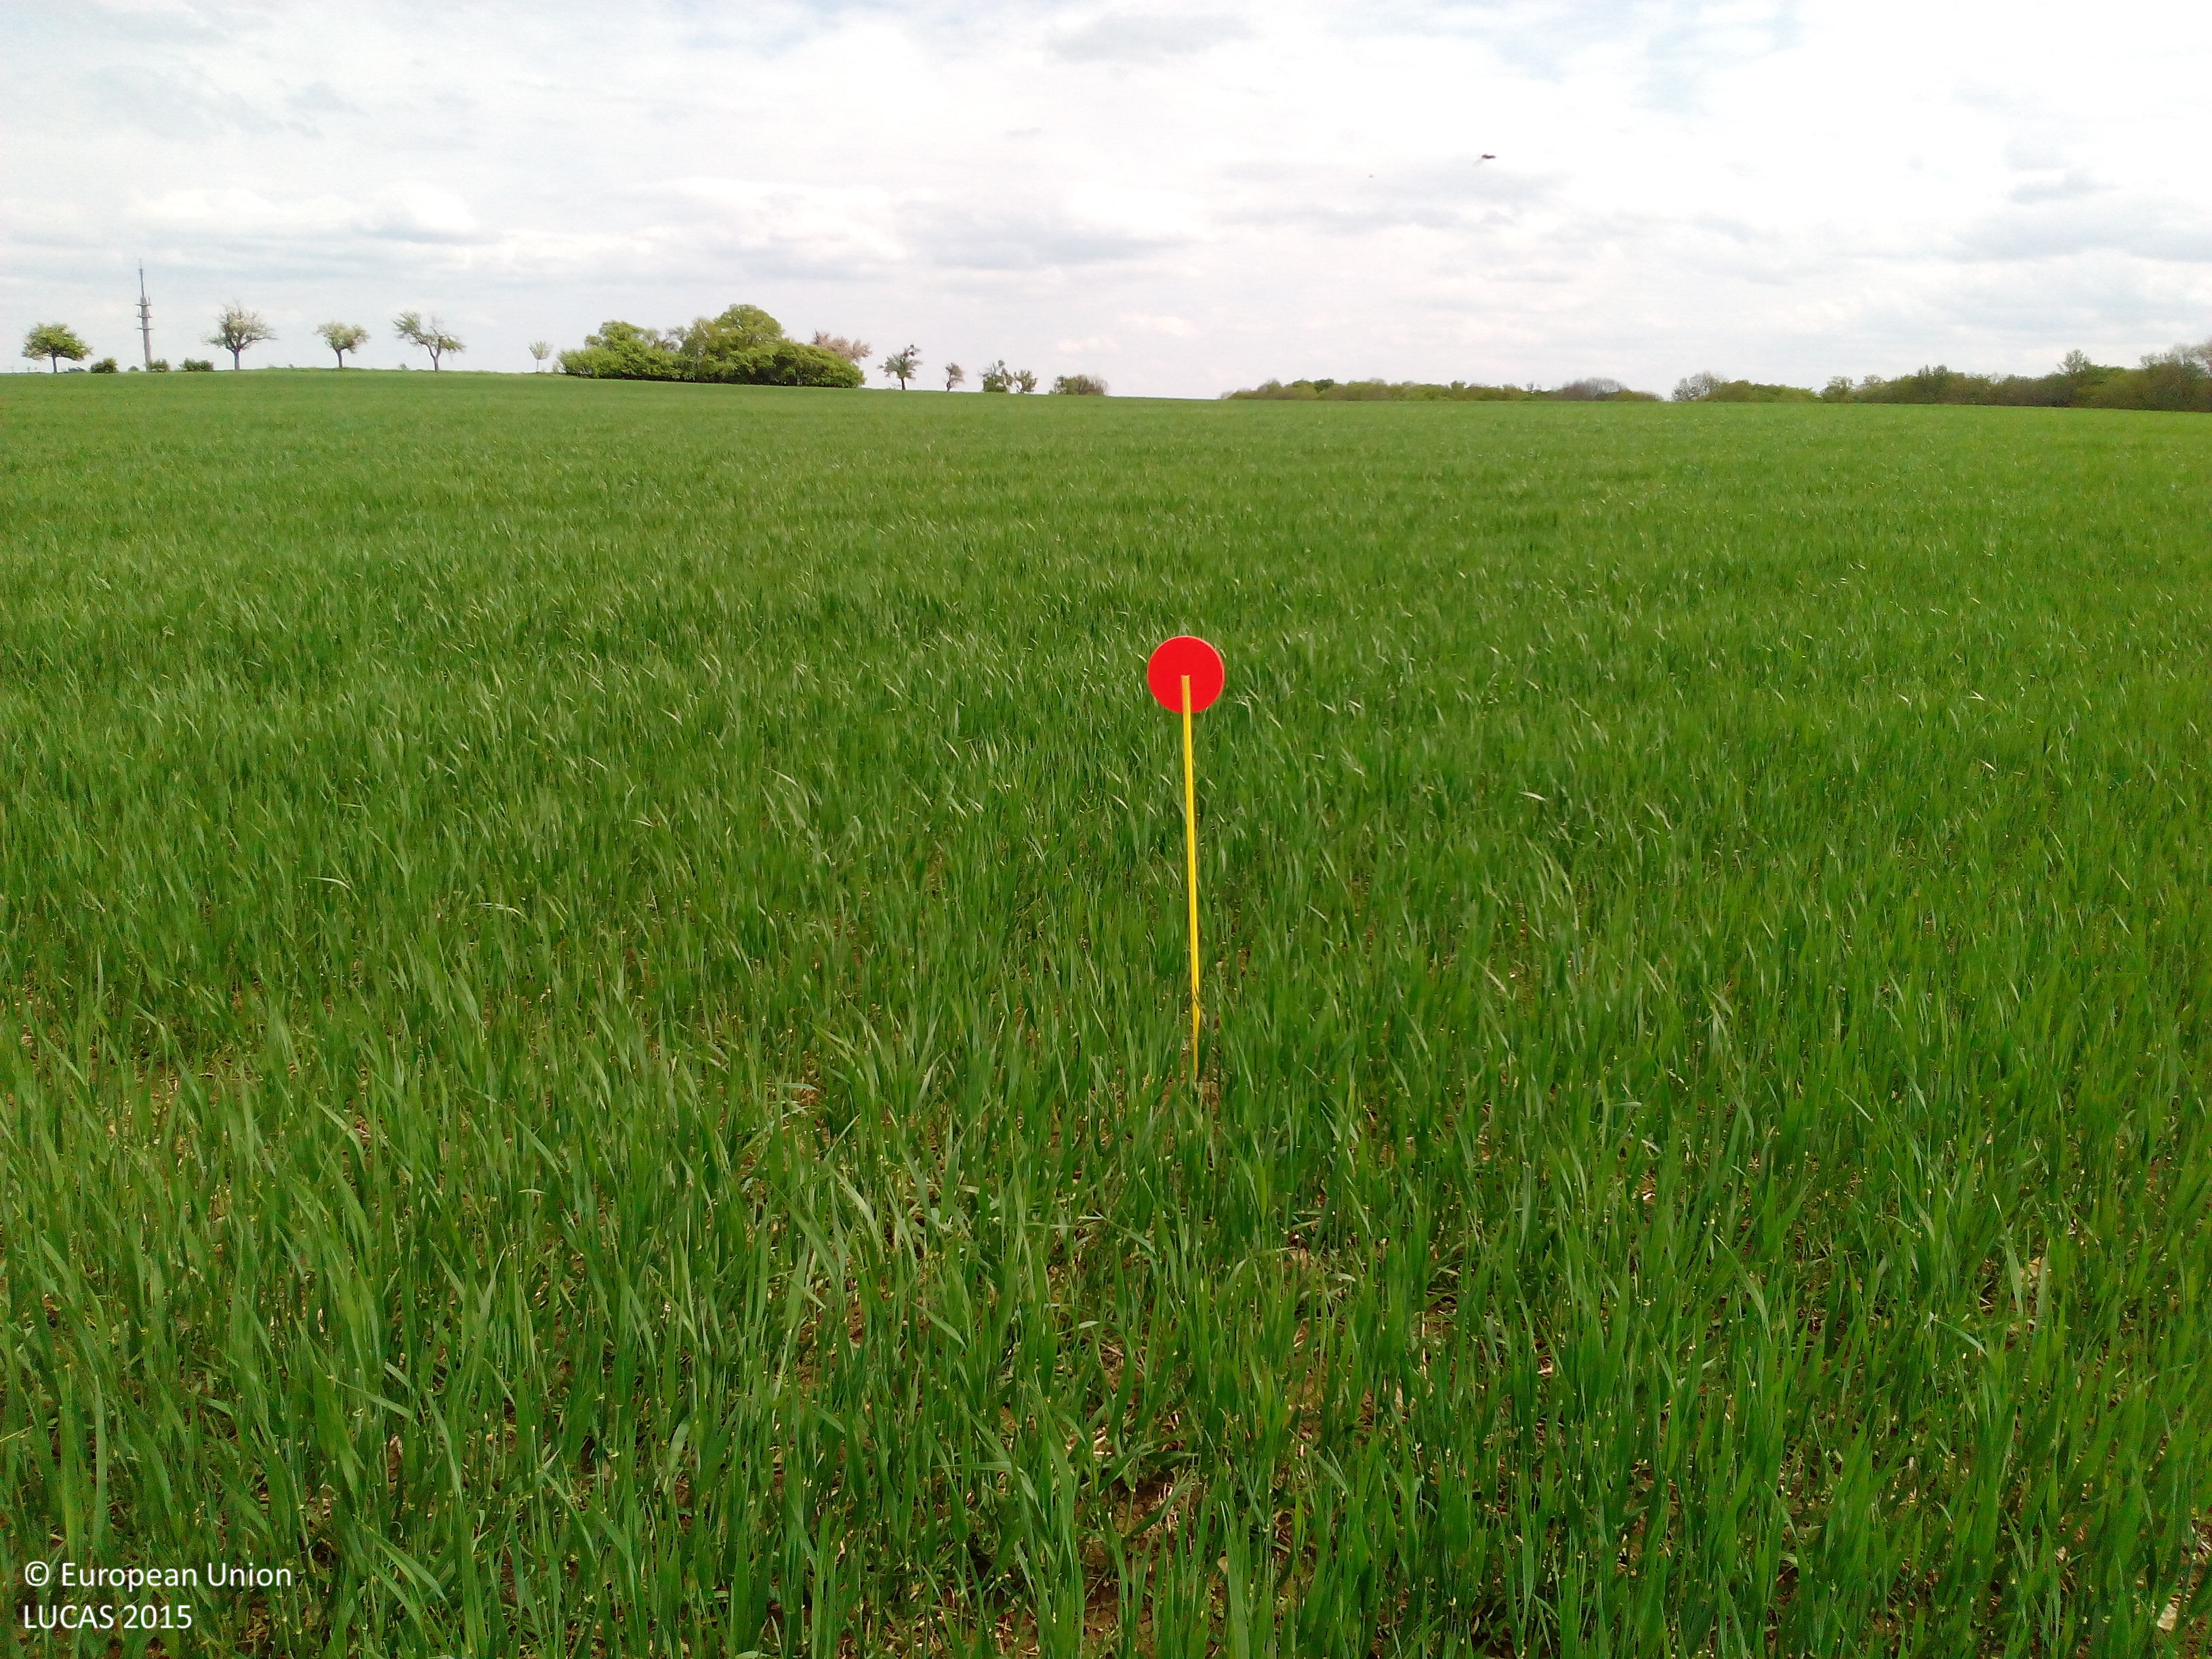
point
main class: Cropland
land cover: Barley
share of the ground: > 75 %
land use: Agriculture (excluding fallow land and kitchen gardens)
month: May
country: DE
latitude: 50.8751
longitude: 11.5487
